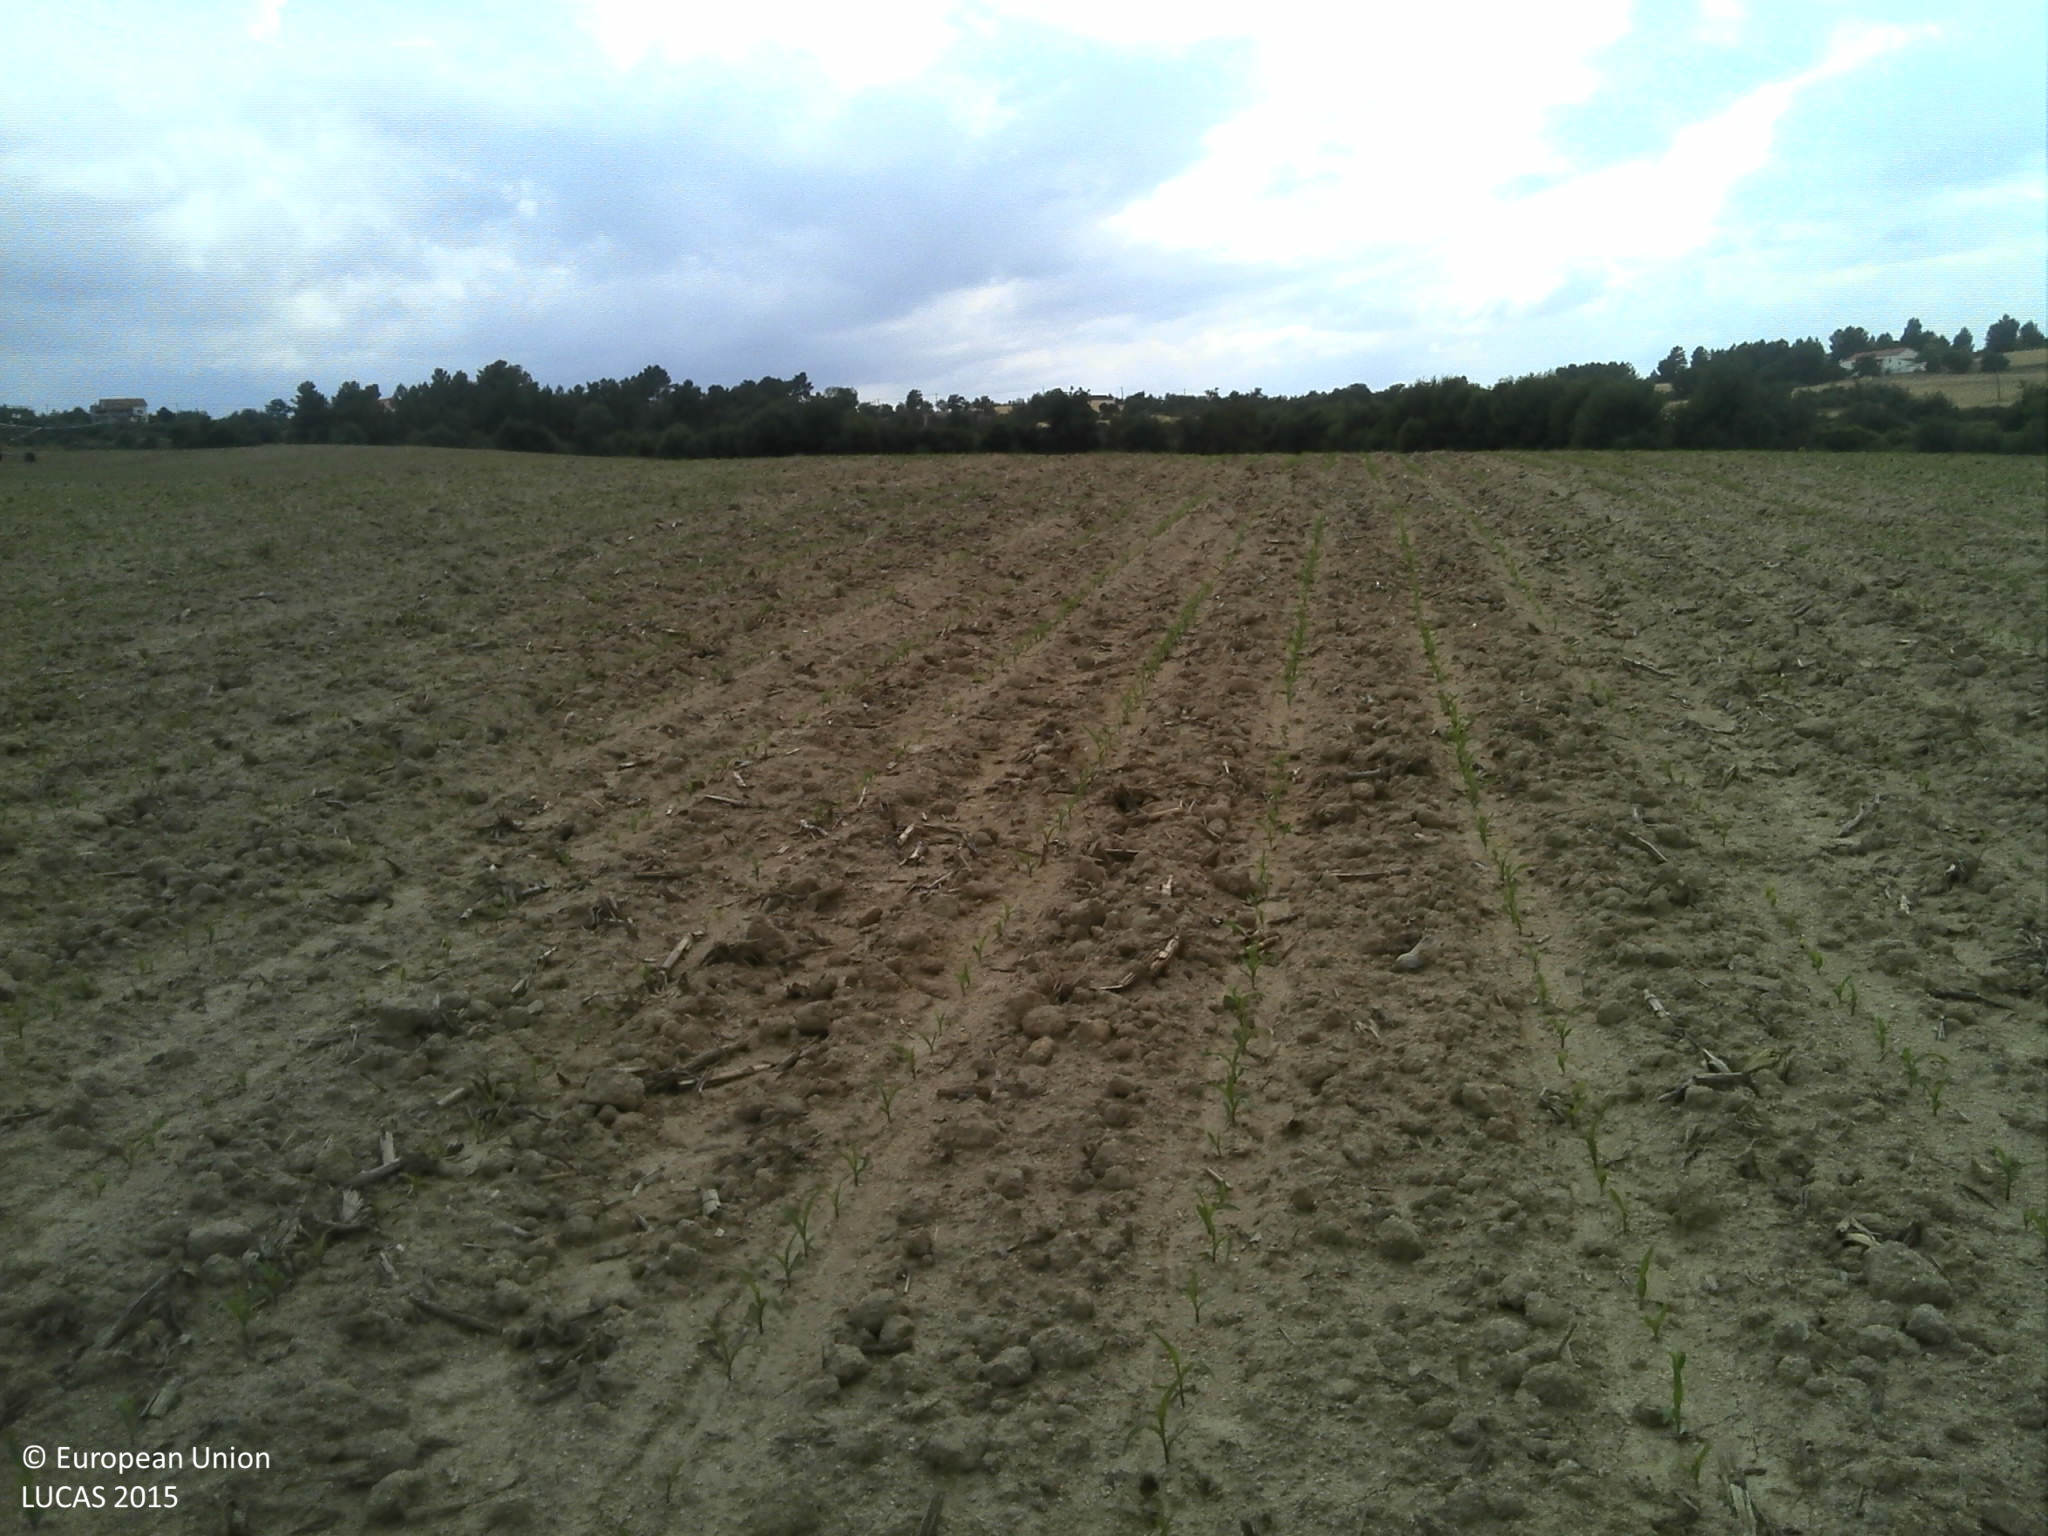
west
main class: Cropland
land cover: Maize
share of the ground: < 10 %
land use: Agriculture (excluding fallow land and kitchen gardens)
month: June
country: PT
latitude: 40.2630
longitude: -7.4253
